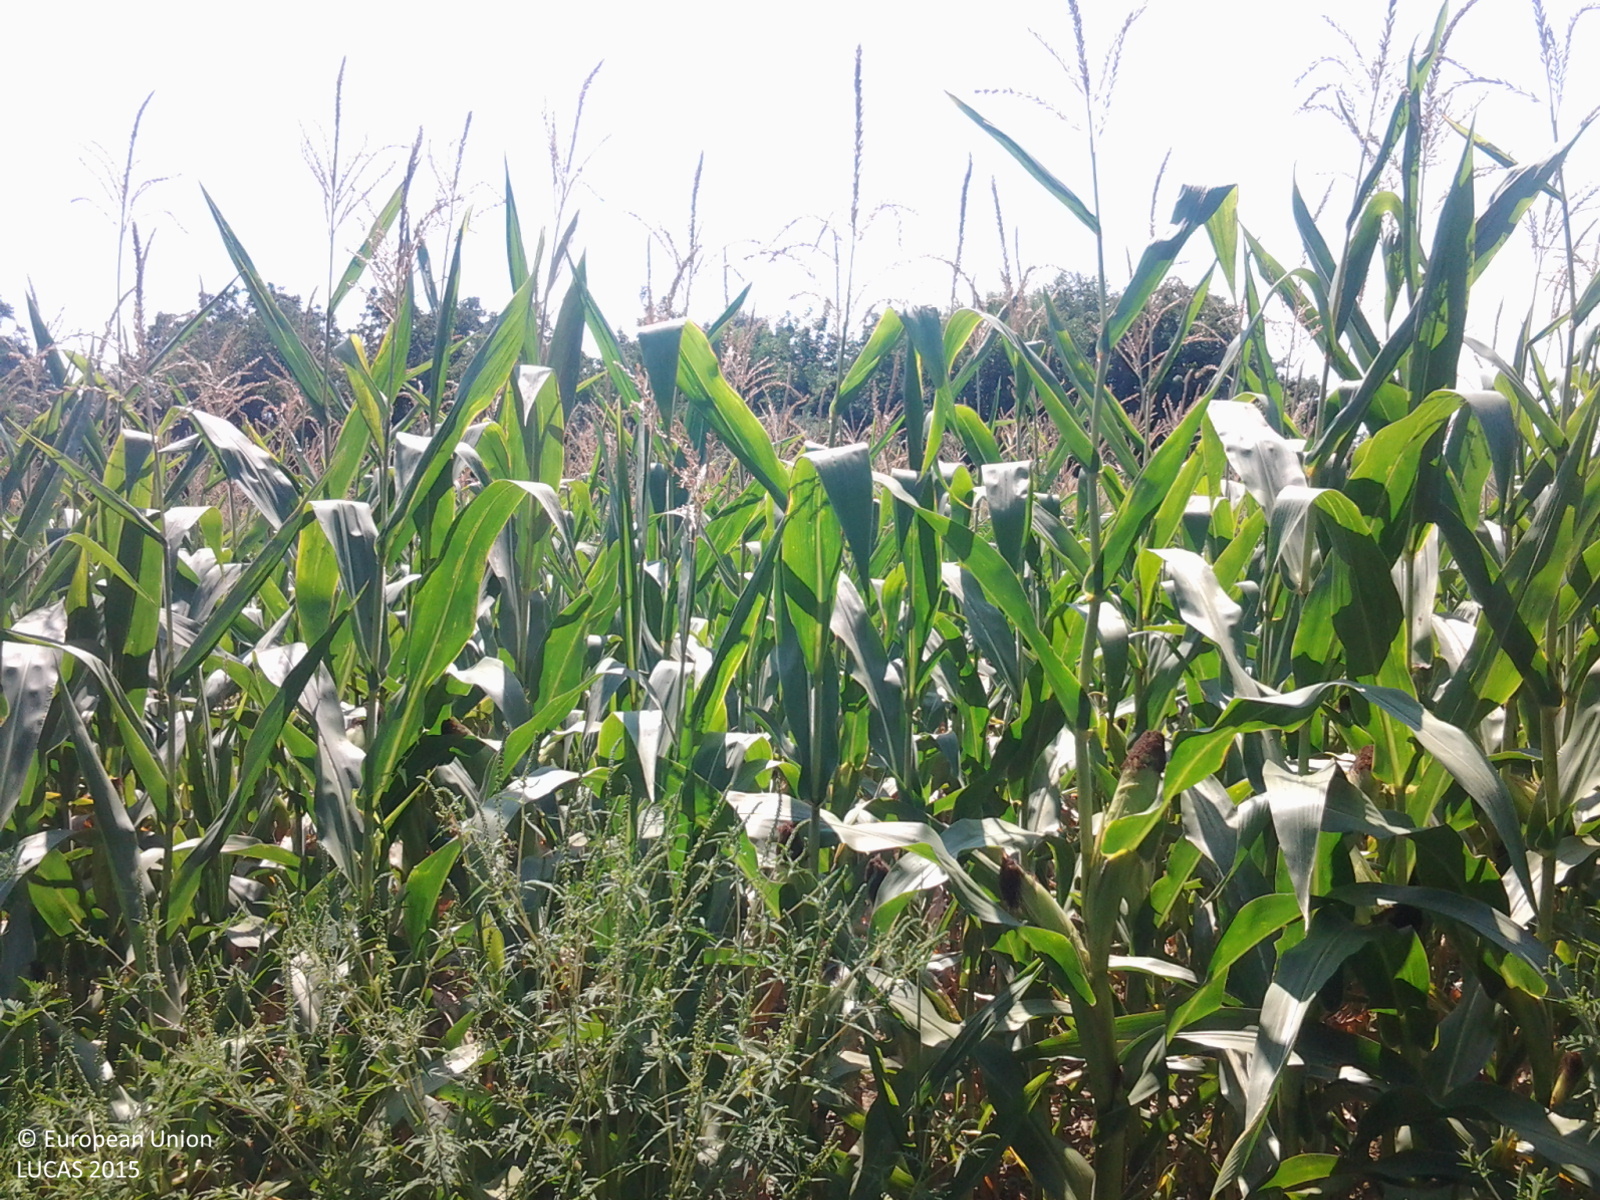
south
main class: Cropland
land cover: Maize
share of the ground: > 75 %
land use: Agriculture (excluding fallow land and kitchen gardens)
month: August
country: HU
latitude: 46.6020
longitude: 17.1184
